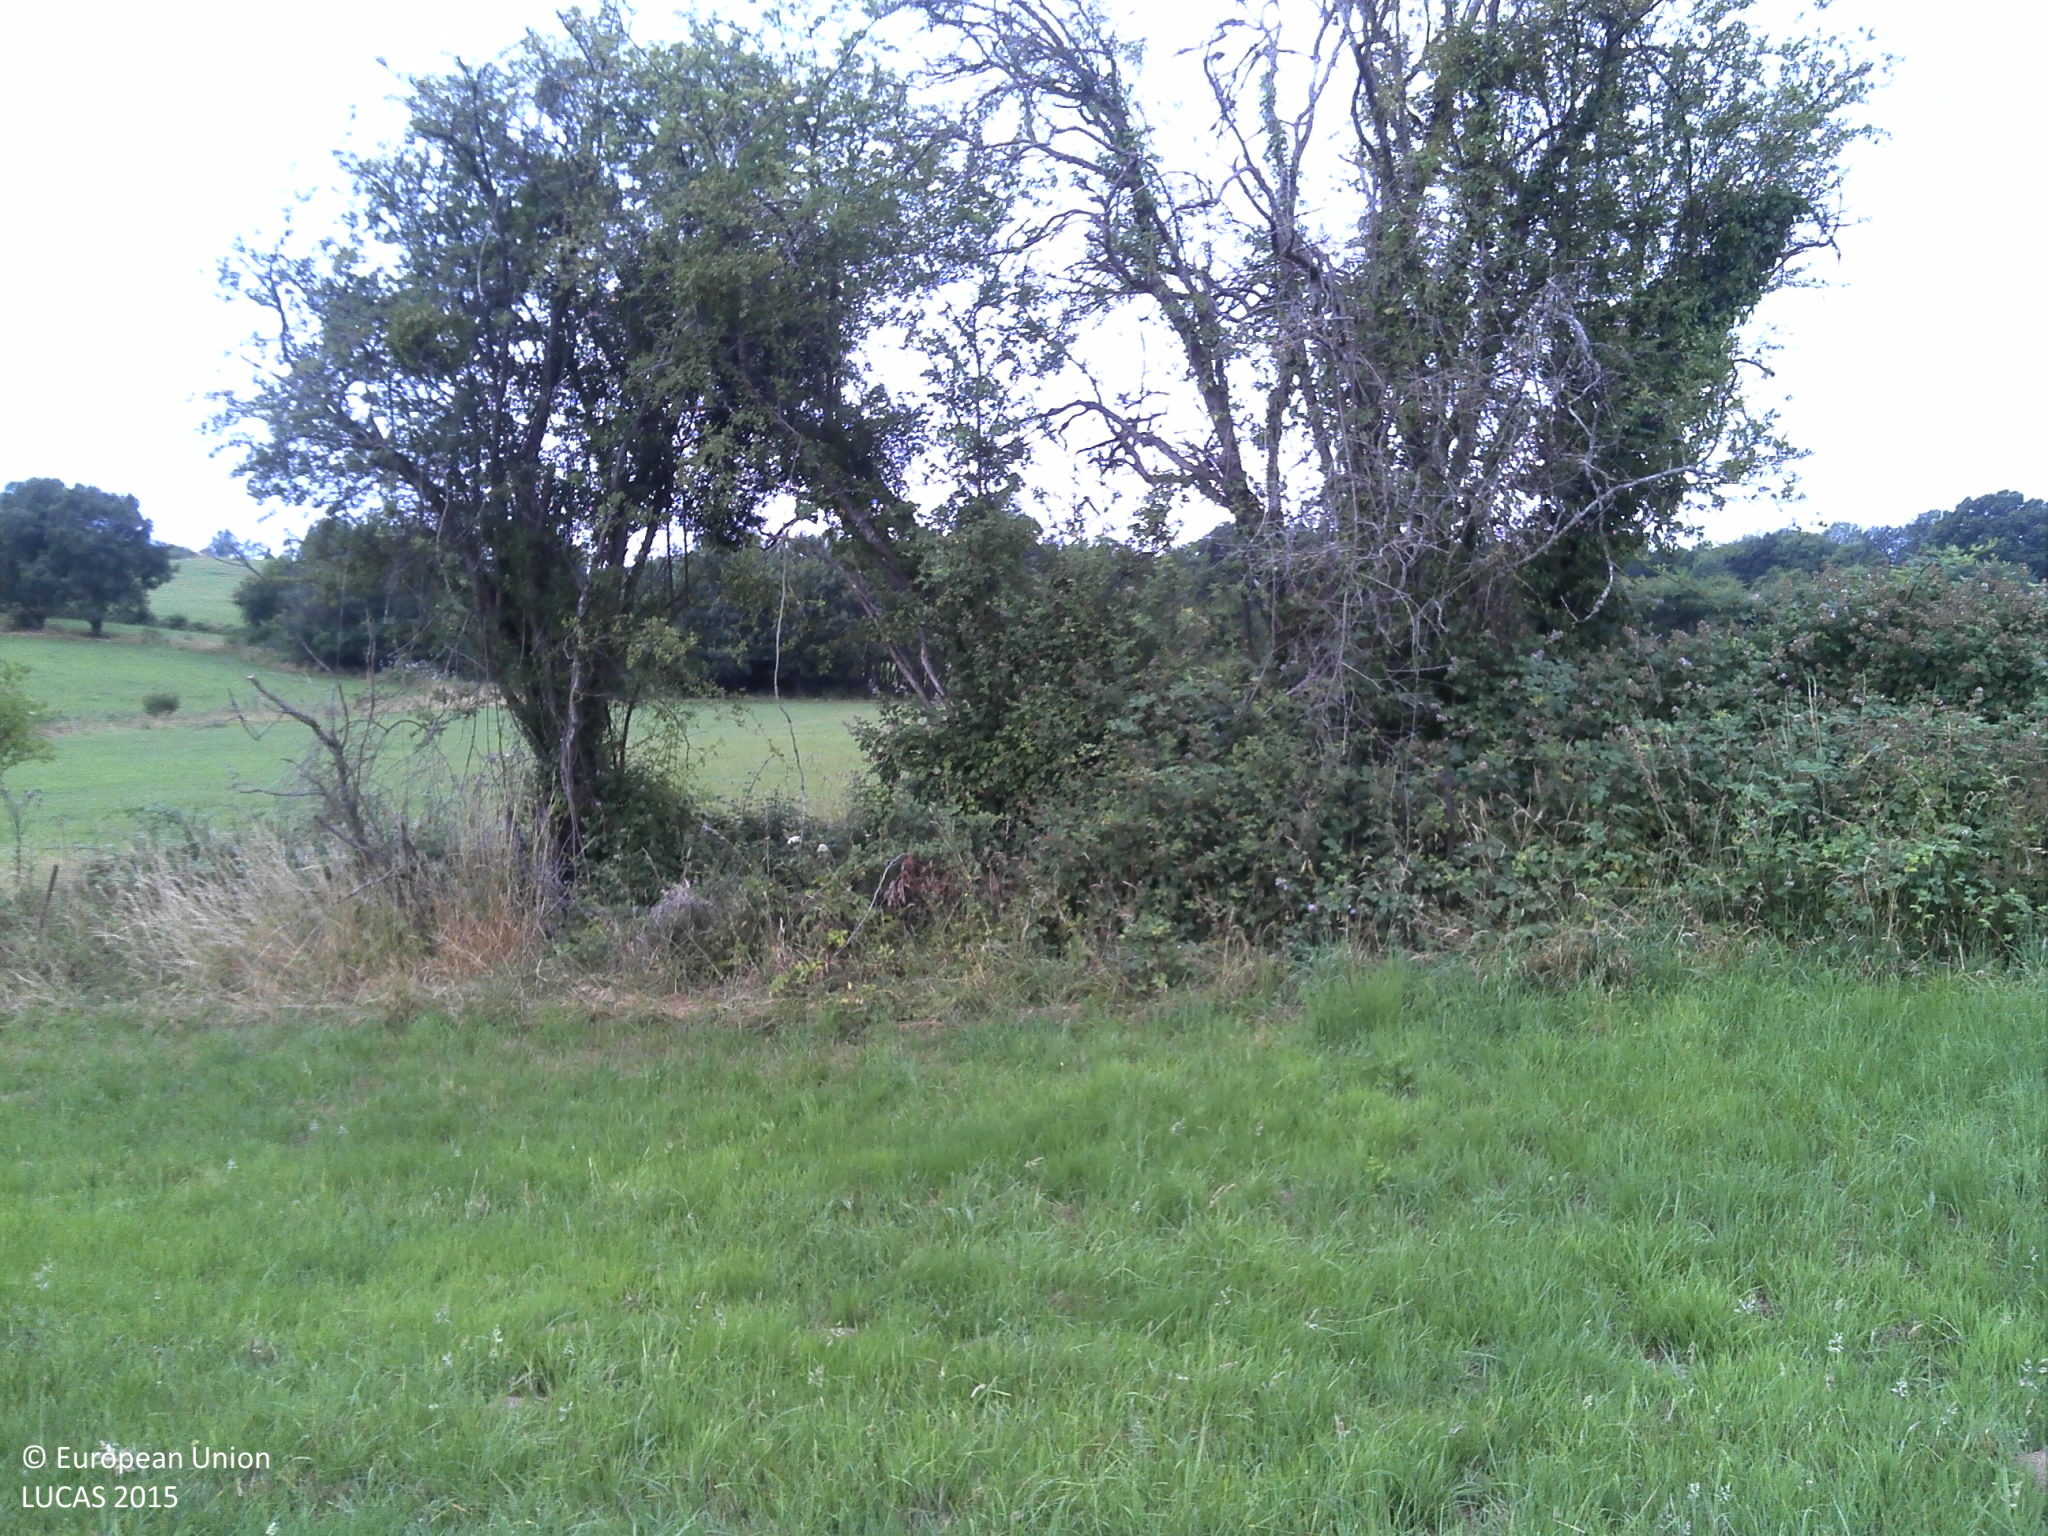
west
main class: Grassland
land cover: Grassland without tree/shrub cover
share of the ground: > 75 %
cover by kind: herbaceous plants 100 %
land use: Agriculture (excluding fallow land and kitchen gardens)
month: July
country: FR
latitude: 49.7909
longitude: 4.7043
